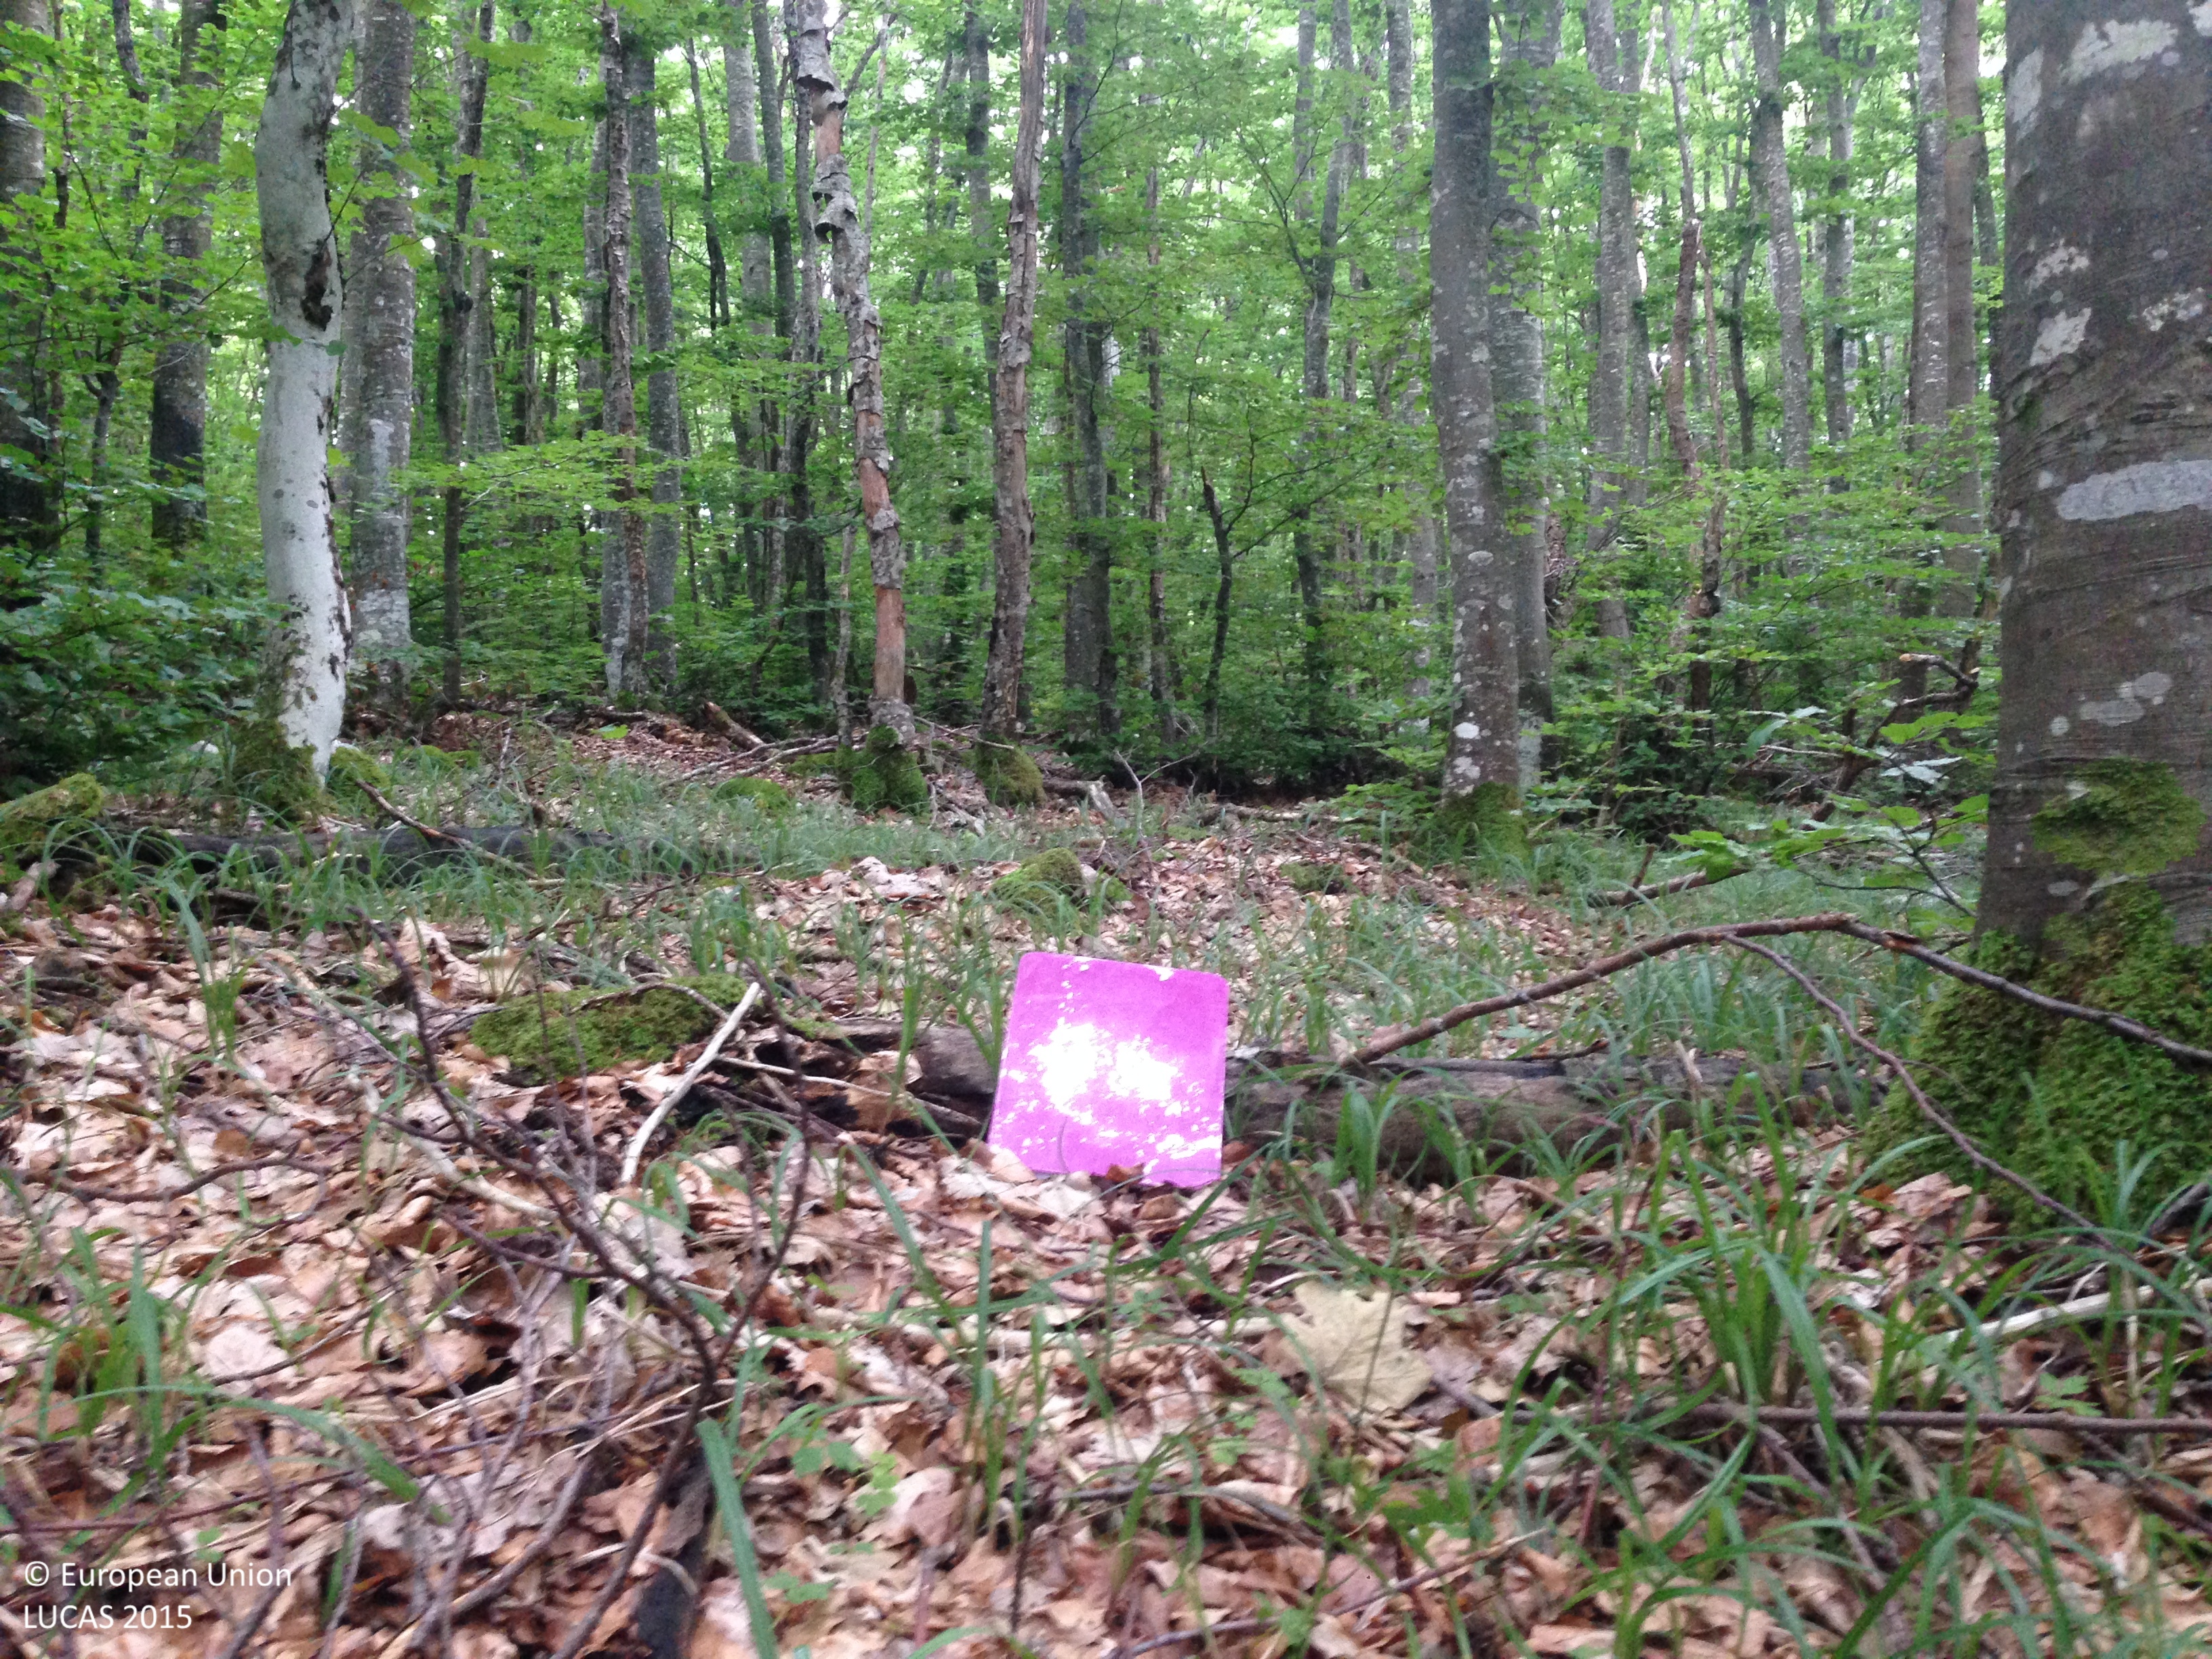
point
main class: Woodland
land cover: Broadleaved woodland
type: mountainous beech forest
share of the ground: > 75 %
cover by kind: broadleaved forest trees 80 %, shrubs 10 %, herbaceous plants 5 %, consolidated bare surface 5 %
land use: Forestry
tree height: > 5 m
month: June
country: HR
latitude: 44.6994
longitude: 15.7110
